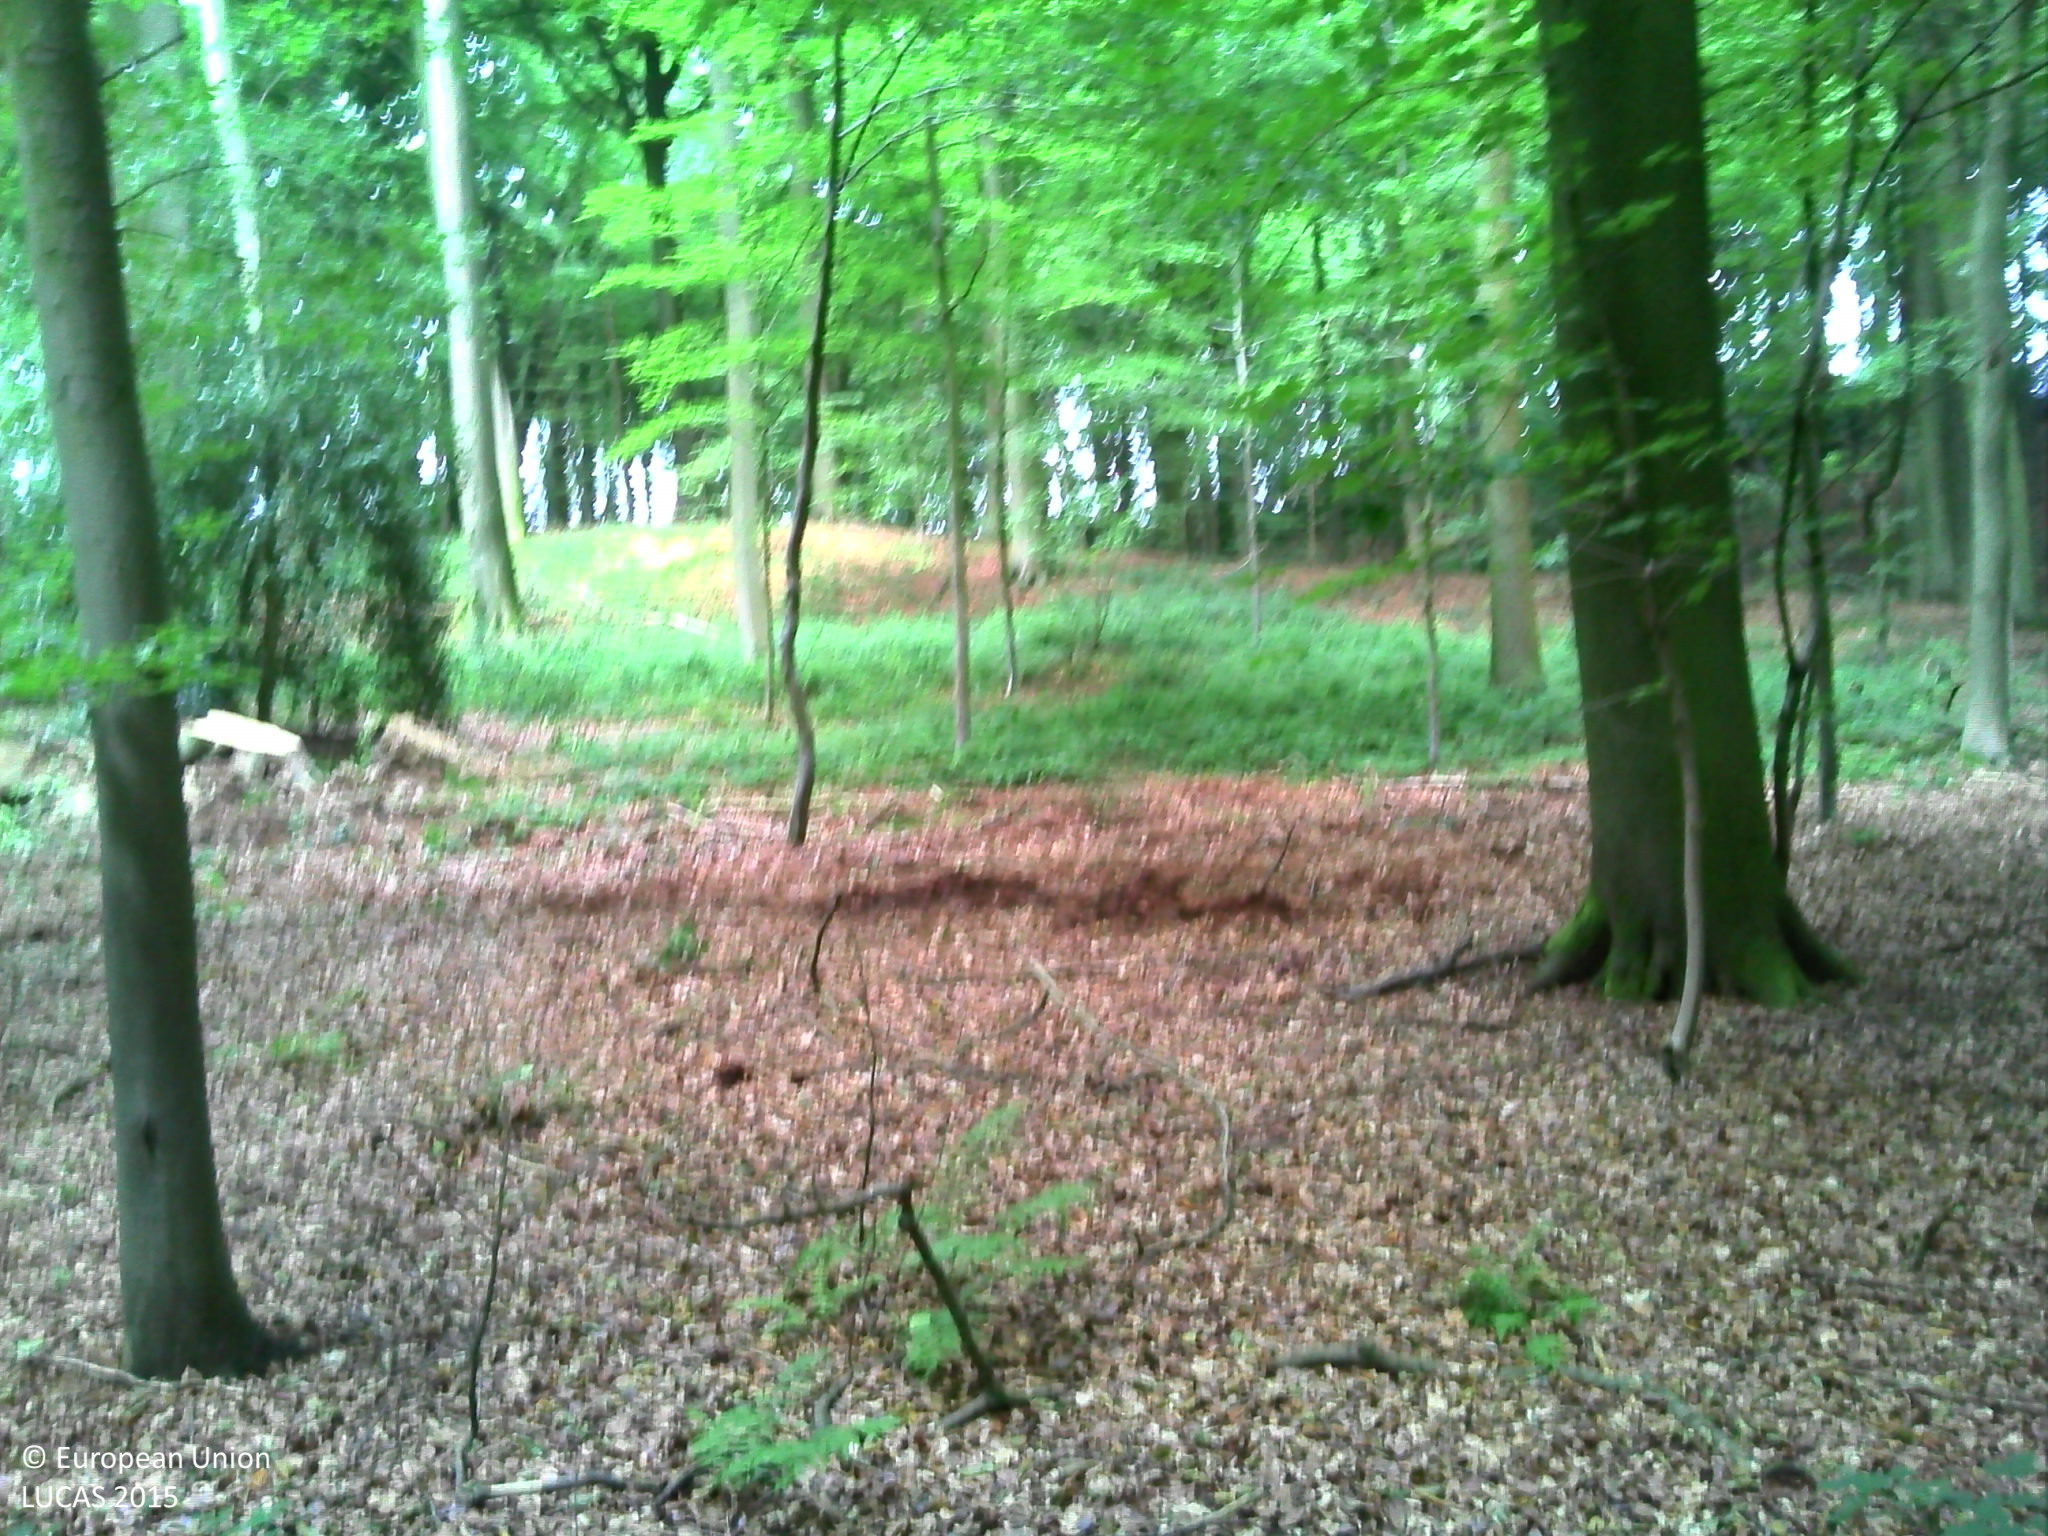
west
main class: Woodland
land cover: Broadleaved woodland
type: beech forest
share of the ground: > 75 %
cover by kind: broadleaved forest trees 90 %, shrubs 5 %, herbaceous plants 5 %
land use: Forestry
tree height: > 5 m
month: August
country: BE
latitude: 50.7098
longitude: 3.6343
